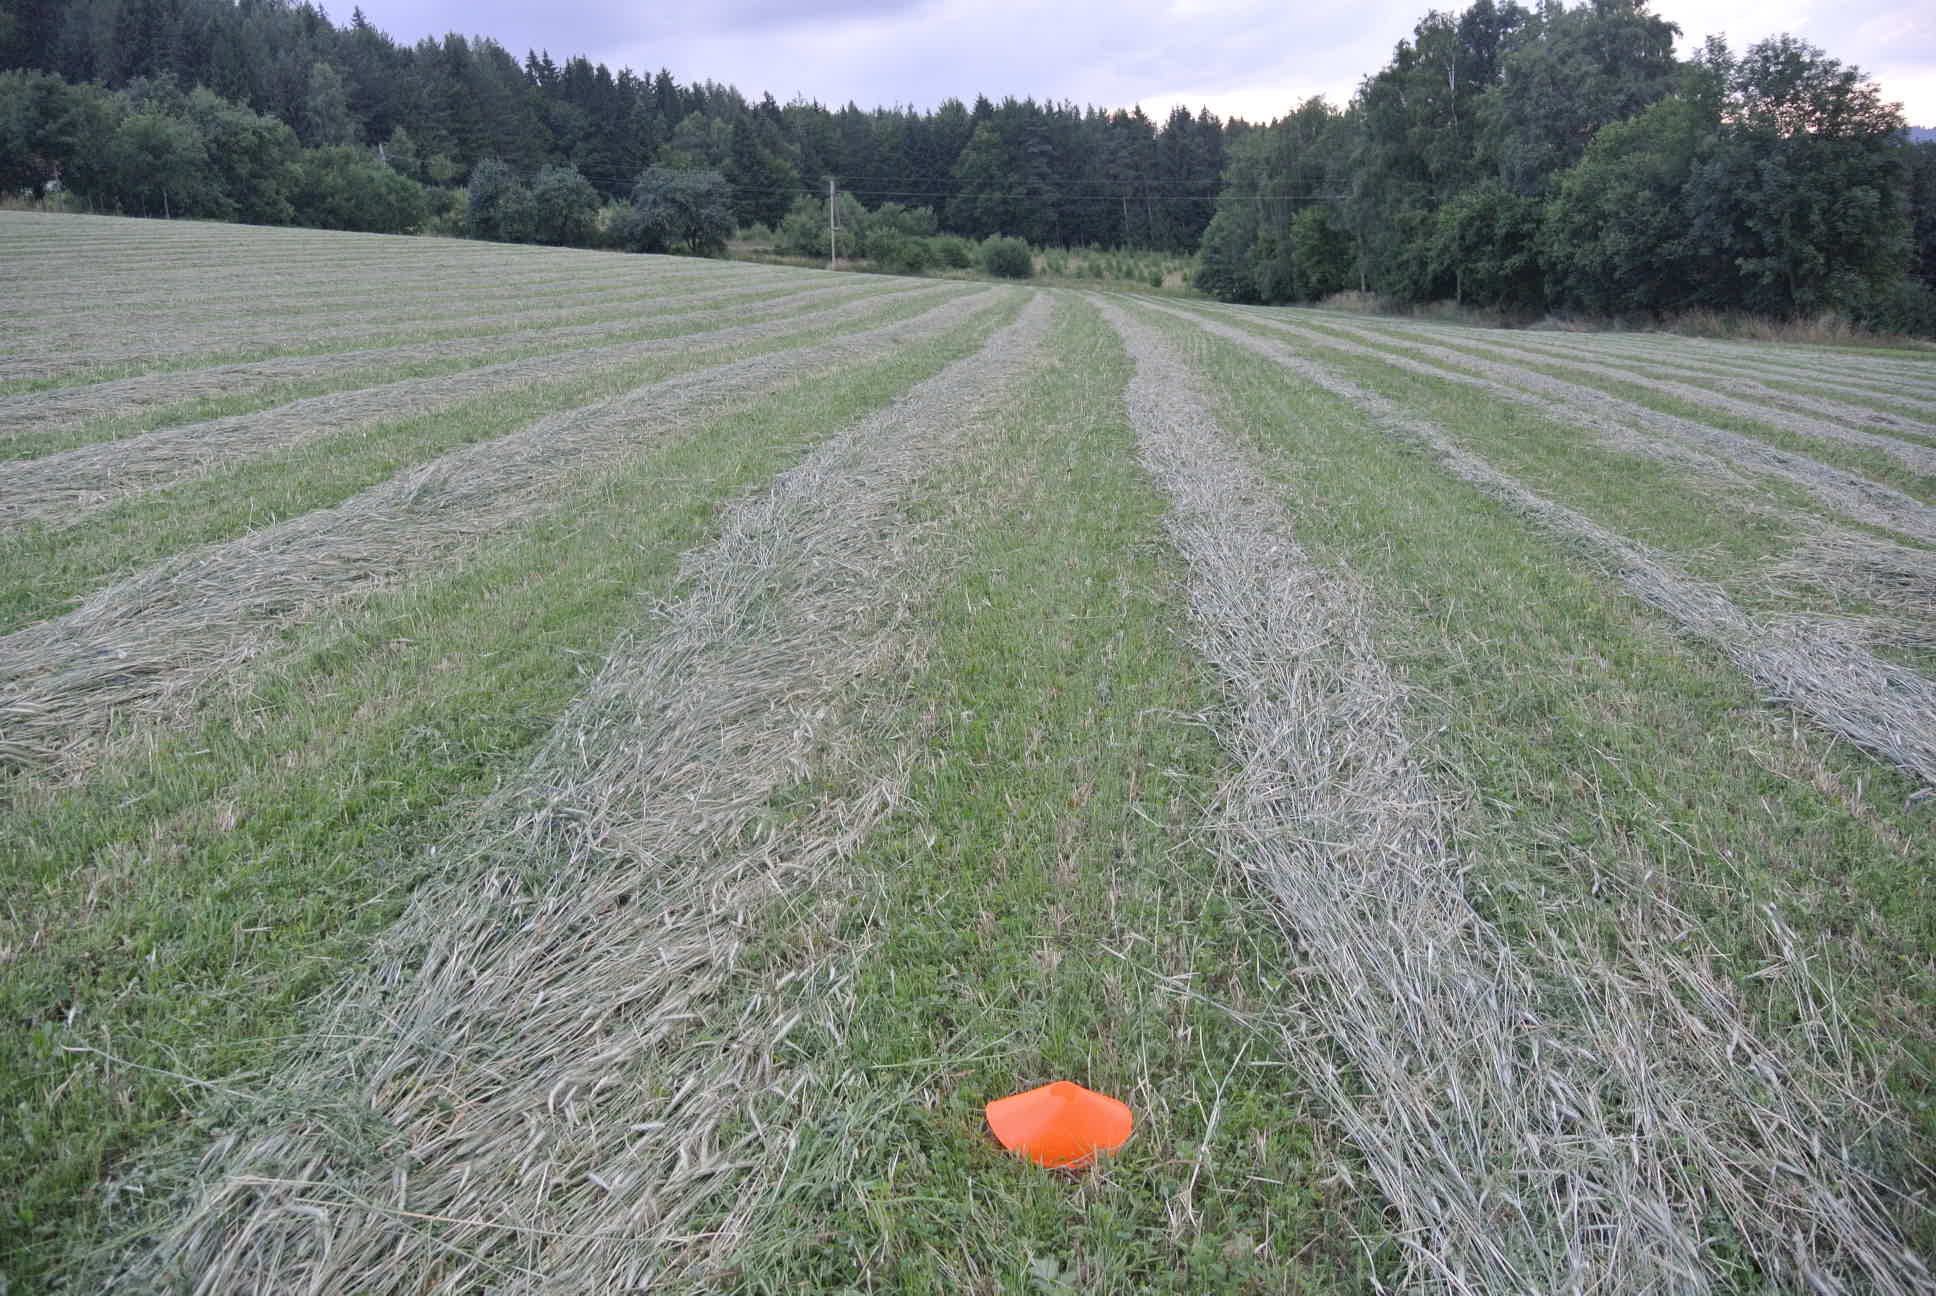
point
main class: Cropland
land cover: Rye
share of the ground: > 75 %
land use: Agriculture (excluding fallow land and kitchen gardens)
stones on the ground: < 10 %
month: July
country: AT
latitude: 47.5313
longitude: 16.0995
